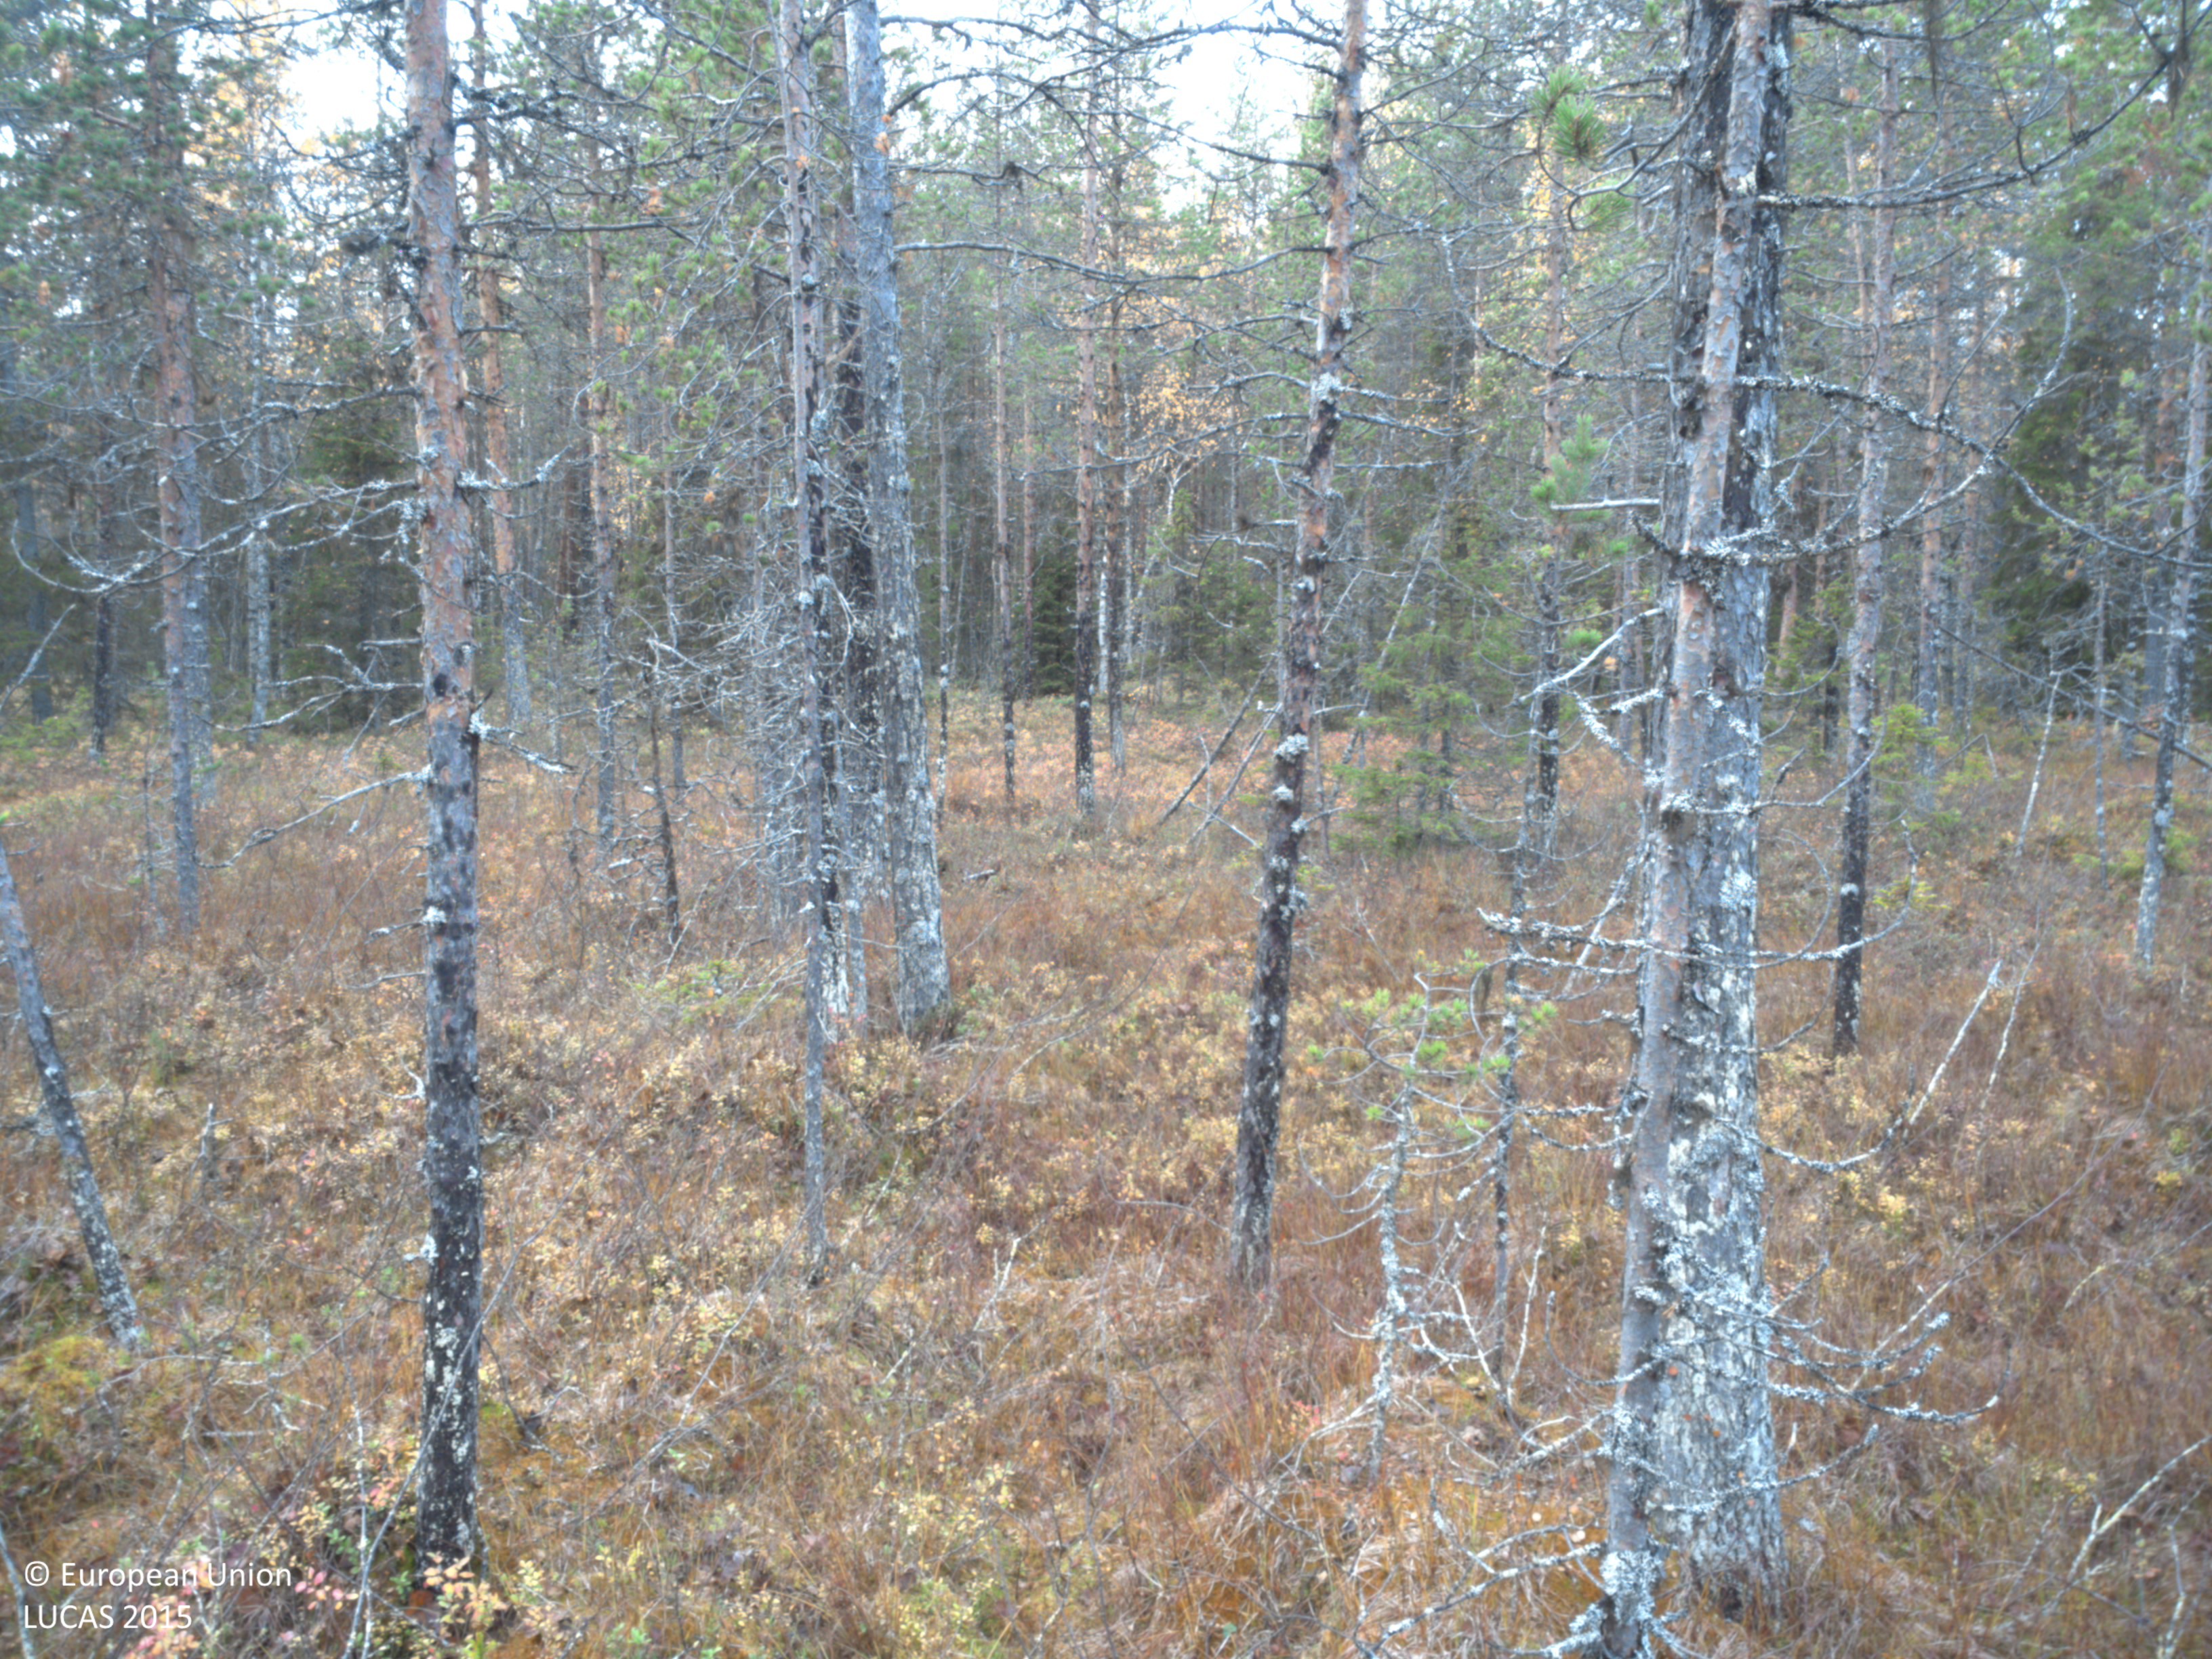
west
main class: Woodland
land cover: Pine dominated coniferous woodland
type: boreal forest
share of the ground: 25 - 50 %
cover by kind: coniferous forest trees 50 %, shrubs 20 %, herbaceous plants 20 %, lichens and mosses 10 %
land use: Forestry
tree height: > 5 m
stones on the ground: < 10 %
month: September
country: SE
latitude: 64.9701
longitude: 18.8409
